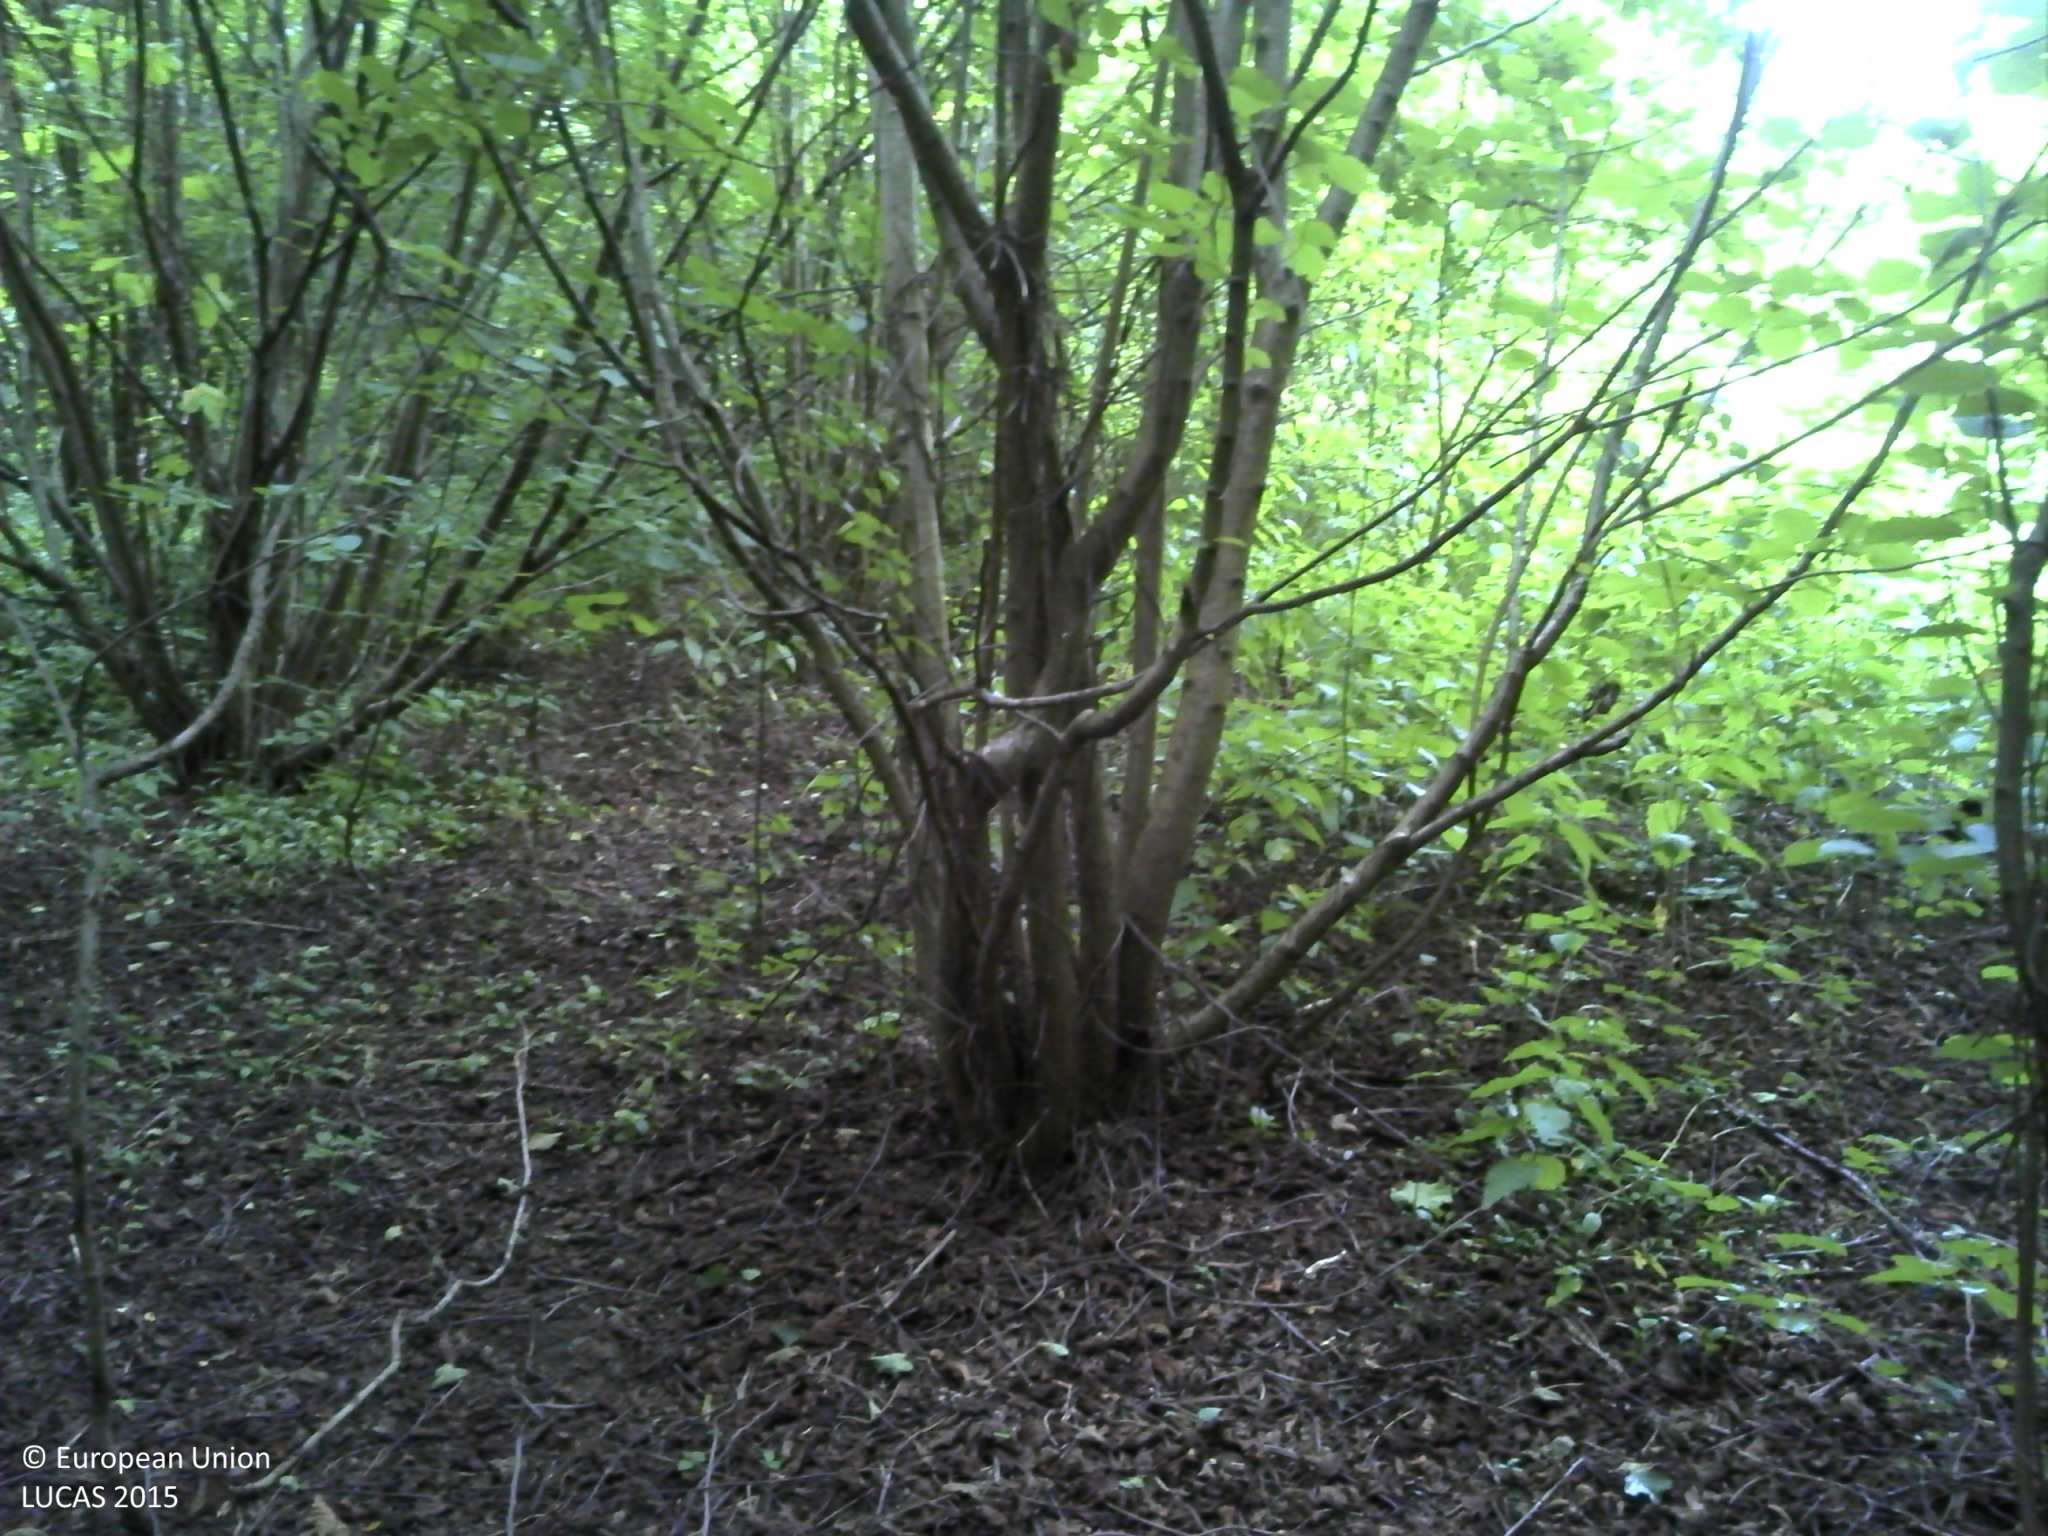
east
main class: Woodland
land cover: Broadleaved woodland
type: acidophilous oak and oak-birch forest
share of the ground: > 75 %
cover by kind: broadleaved forest trees 100 %
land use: Forestry
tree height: > 5 m
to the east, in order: Broadleaved woodland
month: June
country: HR
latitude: 45.3122
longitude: 17.2065
